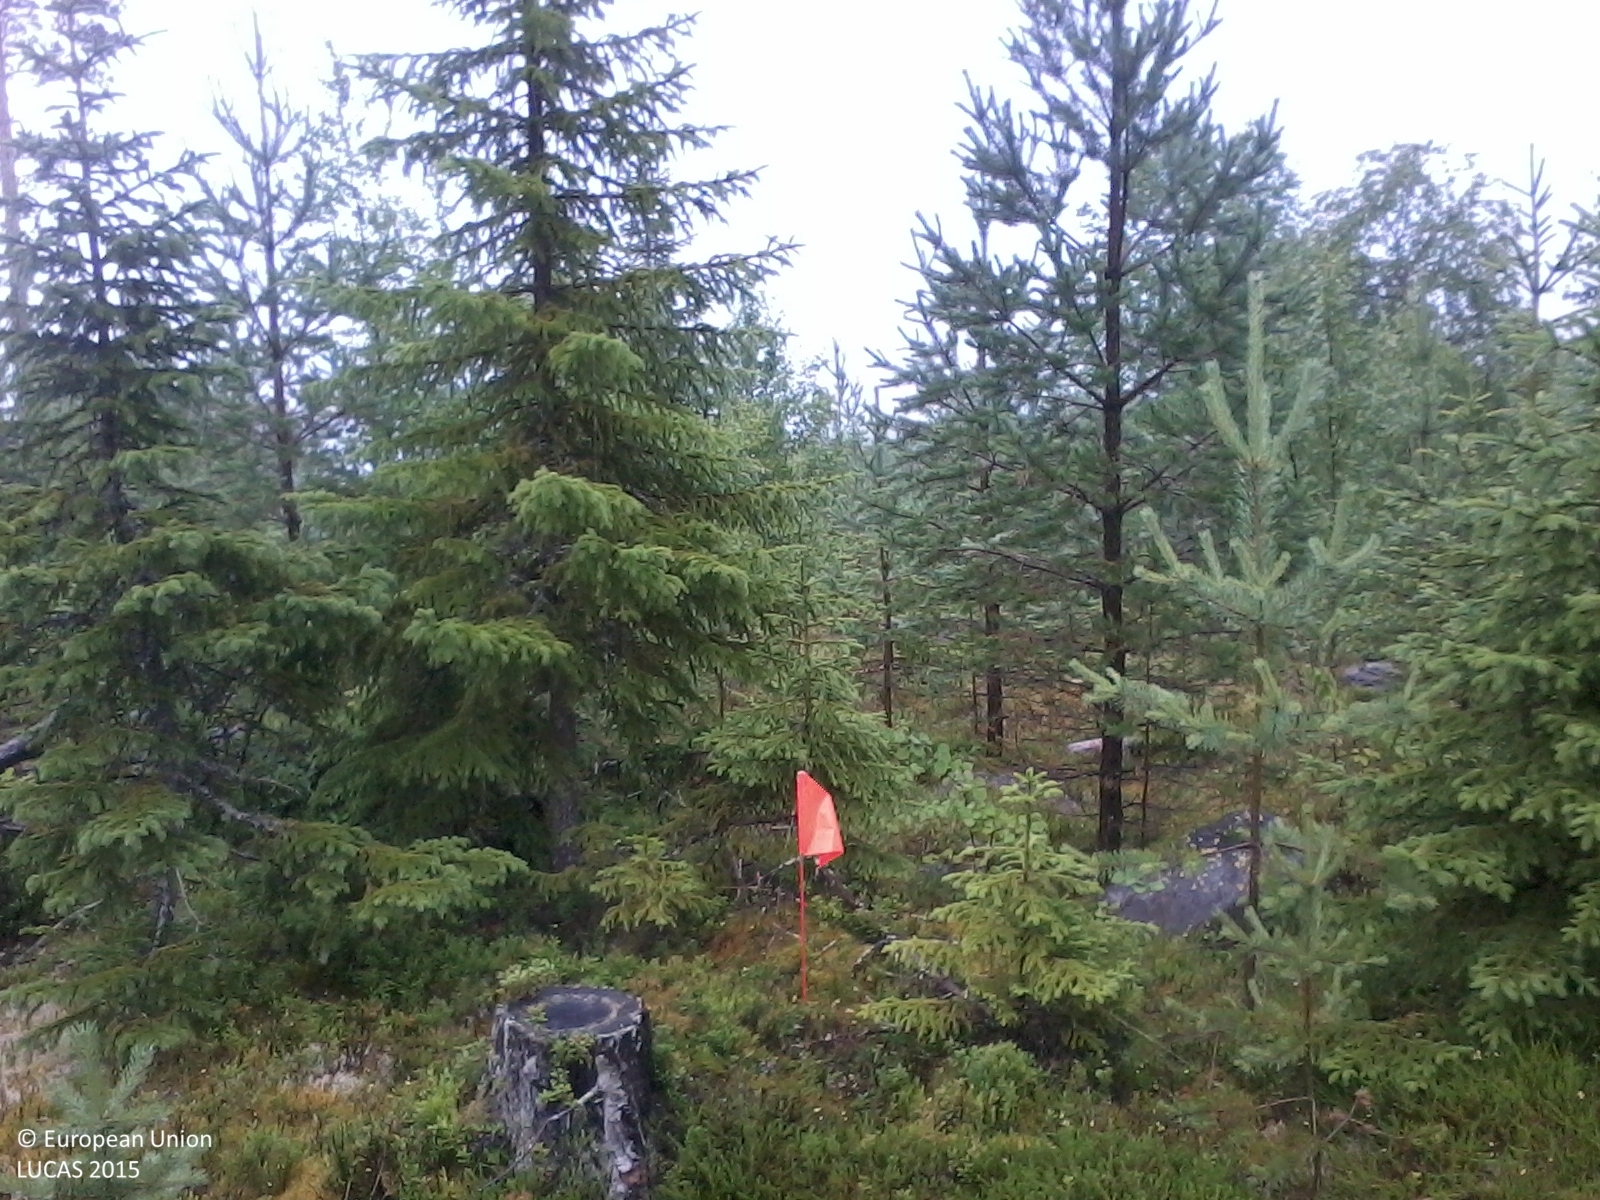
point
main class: Woodland
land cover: Pine dominated mixed woodland
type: boreal forest
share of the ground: 50 - 75 %
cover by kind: coniferous forest trees 40 %, shrubs 25 %, lichens and mosses 20 %, broadleaved forest trees 15 %
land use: Forestry
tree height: < 5 m
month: August
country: SE
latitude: 62.8914
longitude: 16.8422
